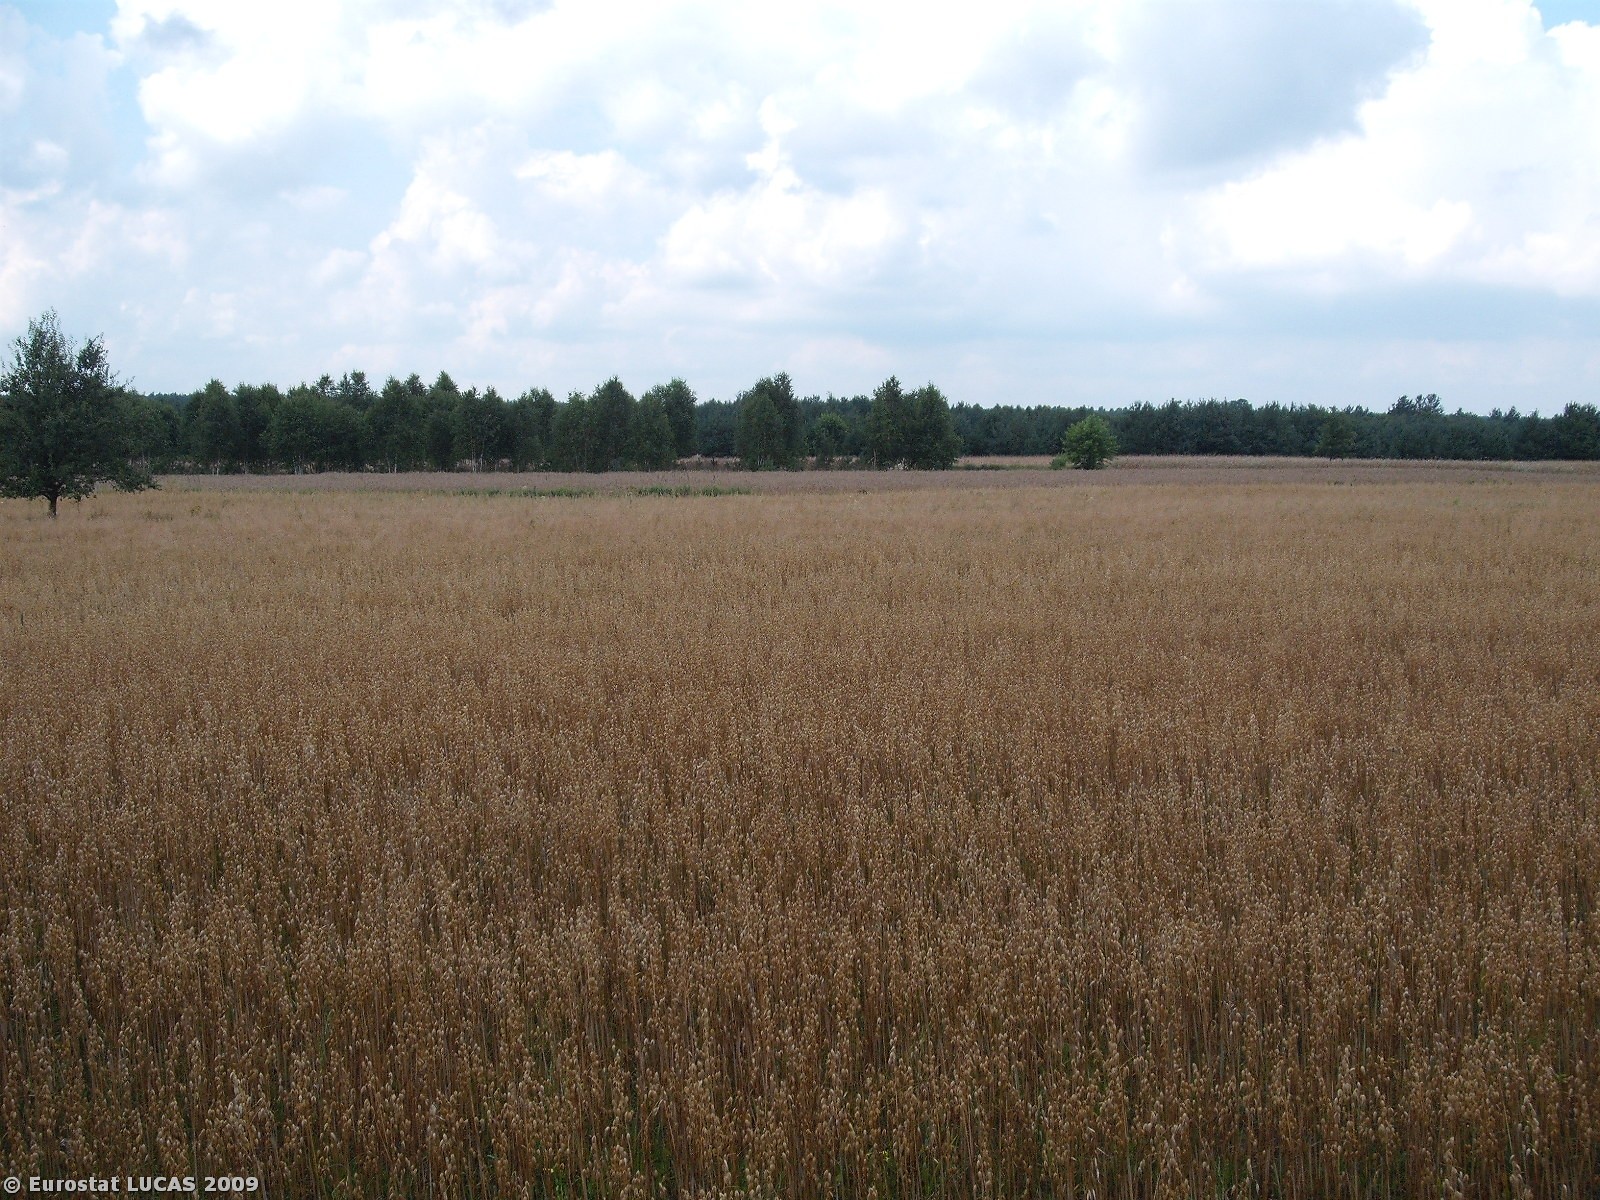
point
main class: Cropland
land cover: Oats
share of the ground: > 75 %
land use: Agriculture (excluding fallow land and kitchen gardens)
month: July
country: PL
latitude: 51.0080
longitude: 21.4088
